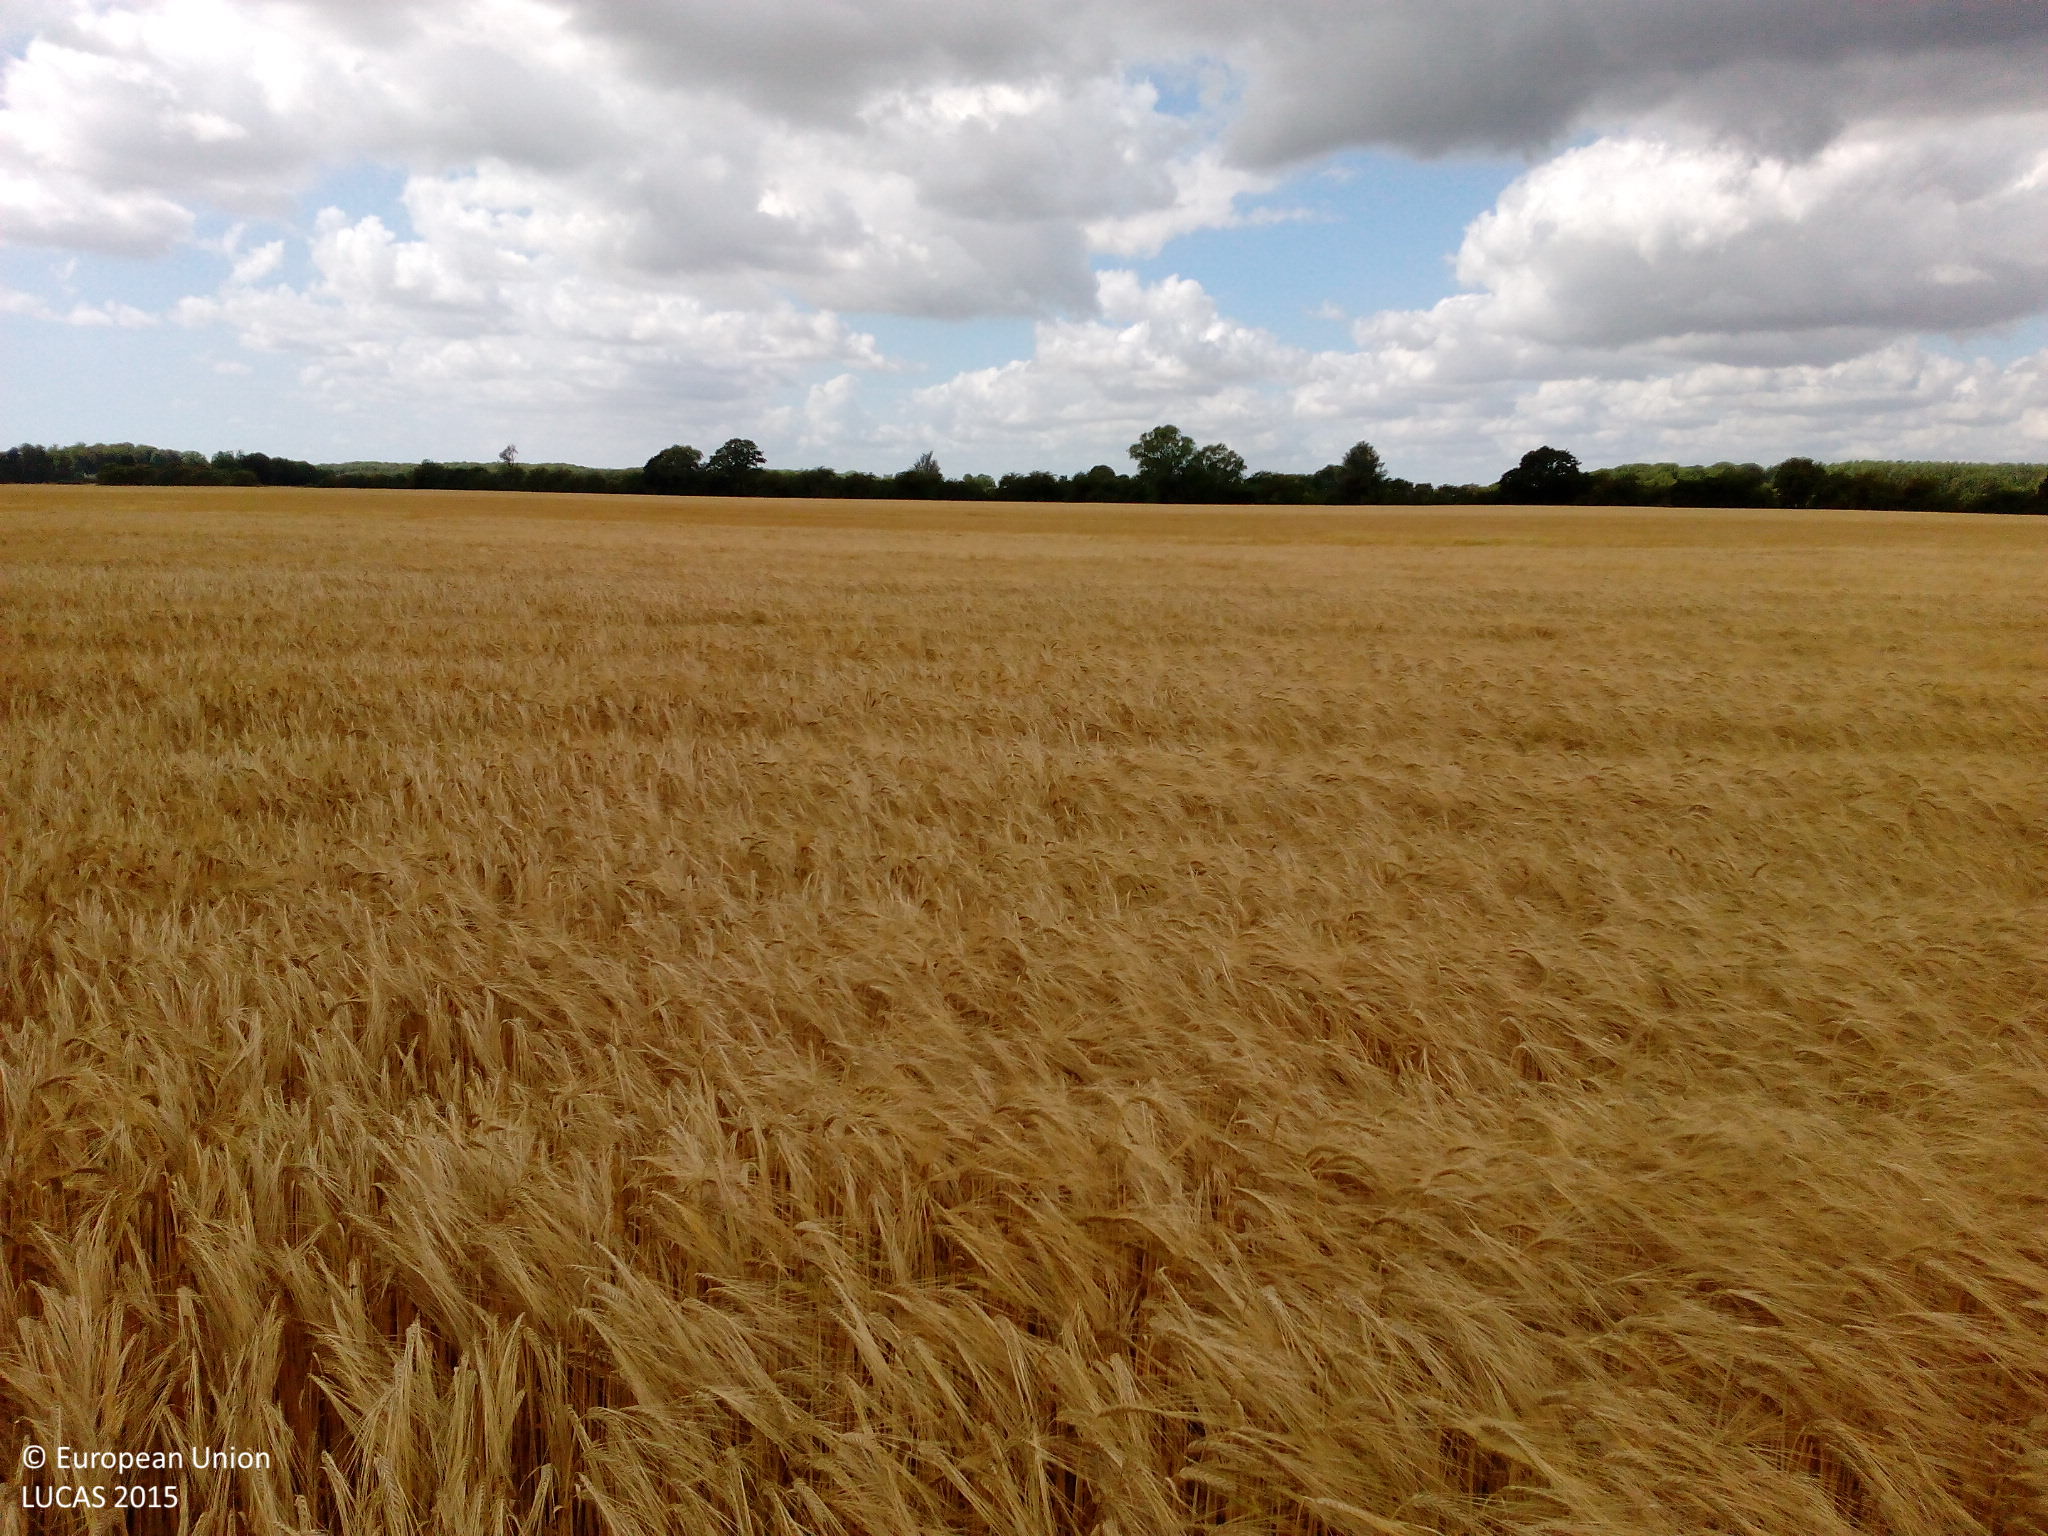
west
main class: Cropland
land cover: Barley
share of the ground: > 75 %
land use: Agriculture (excluding fallow land and kitchen gardens)
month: August
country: DK
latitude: 55.3419
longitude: 12.1901
